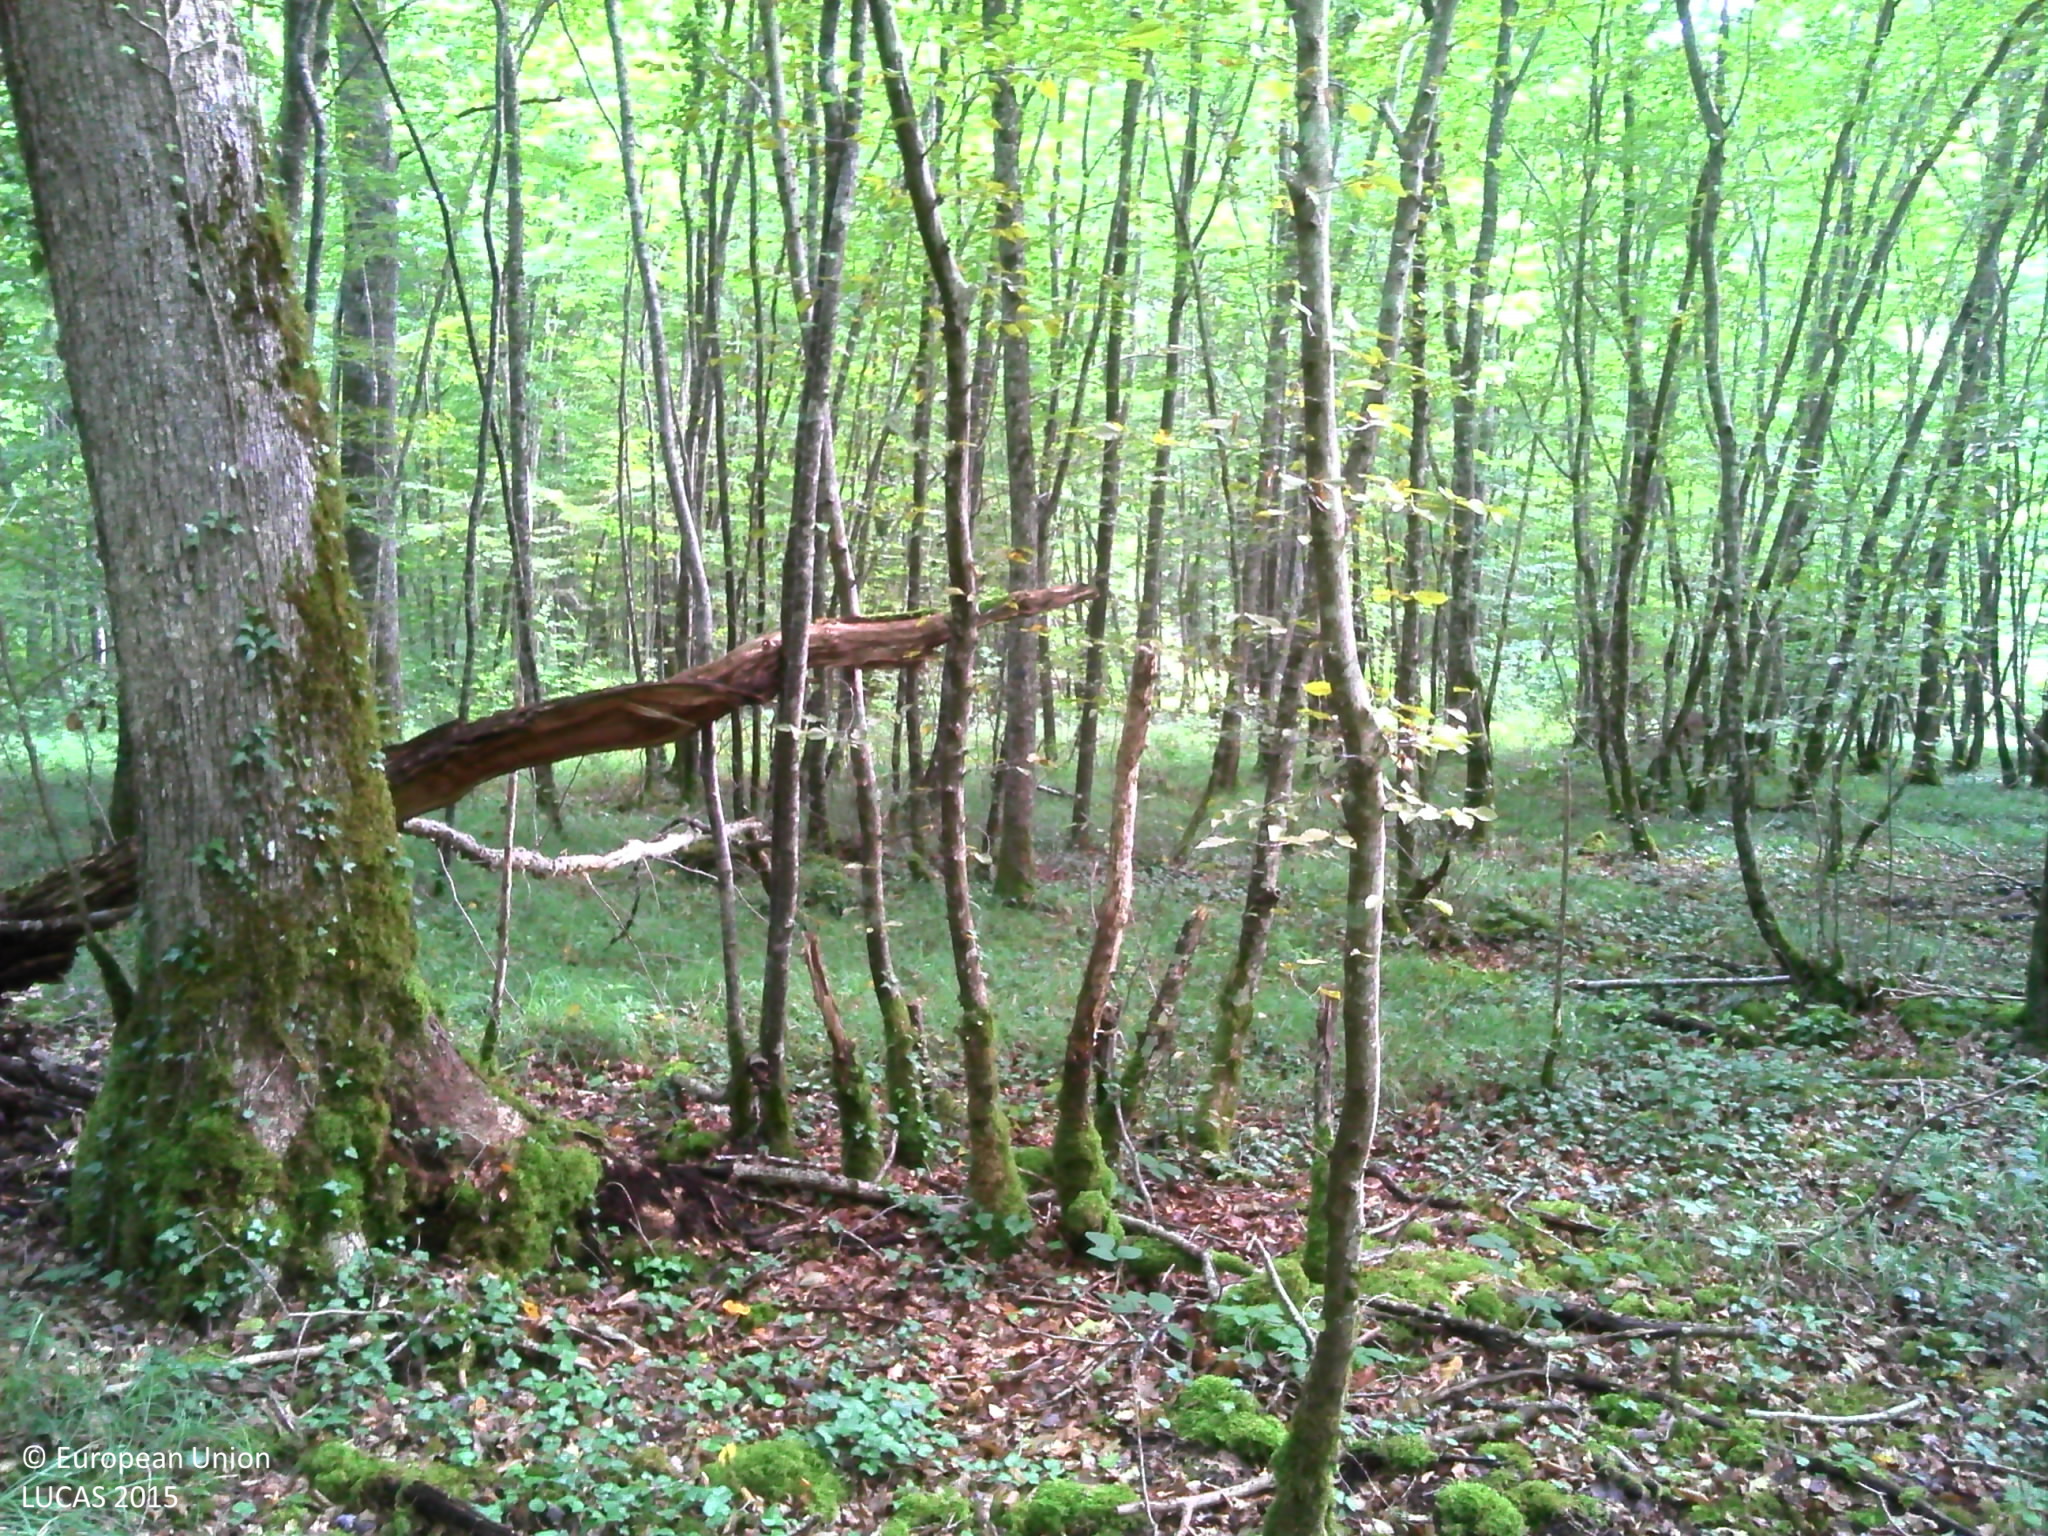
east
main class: Woodland
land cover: Broadleaved woodland
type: mesophytic deciduous forest
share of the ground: > 75 %
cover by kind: broadleaved forest trees 90 %, herbaceous plants 5 %, lichens and mosses 5 %
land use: Forestry
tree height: > 5 m
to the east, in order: Broadleaved woodland; Tracks; Broadleaved woodland
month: September
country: FR
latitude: 47.9309
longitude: 4.2823
